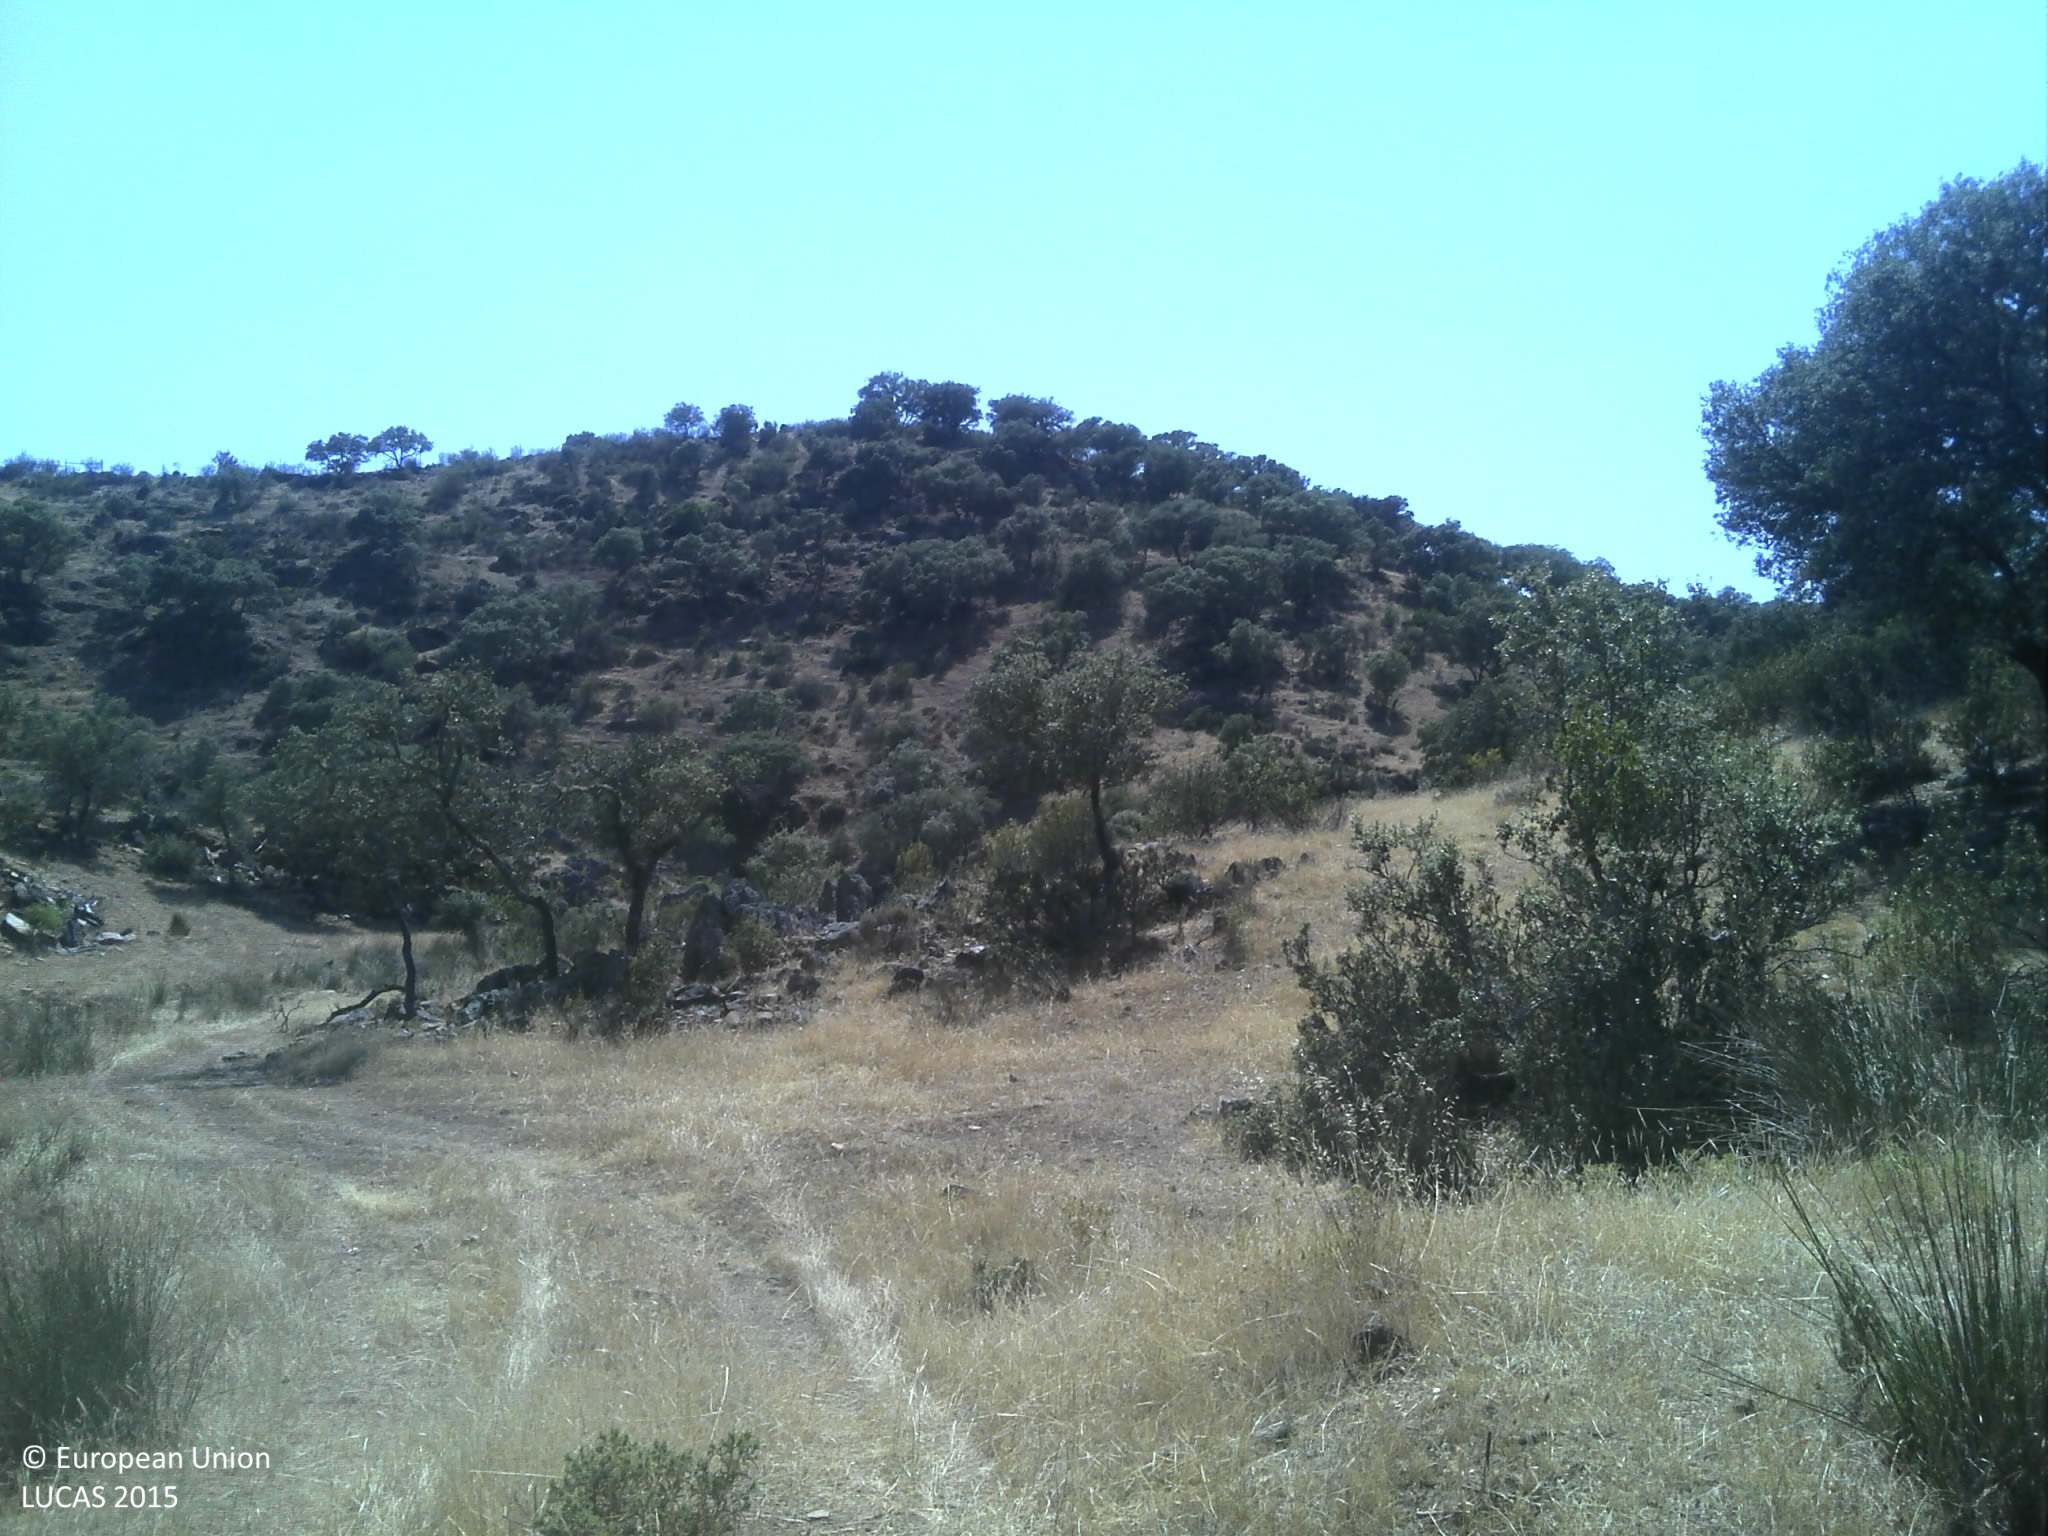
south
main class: Shrubland
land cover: Shrubland with sparse tree cover
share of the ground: 50 - 75 %
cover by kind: shrubs 55 %, herbaceous plants 25 %, unconsolidated bare surface 10 %, broadleaved forest trees 5 %
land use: Forestry
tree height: > 5 m
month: June
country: PT
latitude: 39.6722
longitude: -7.1195
